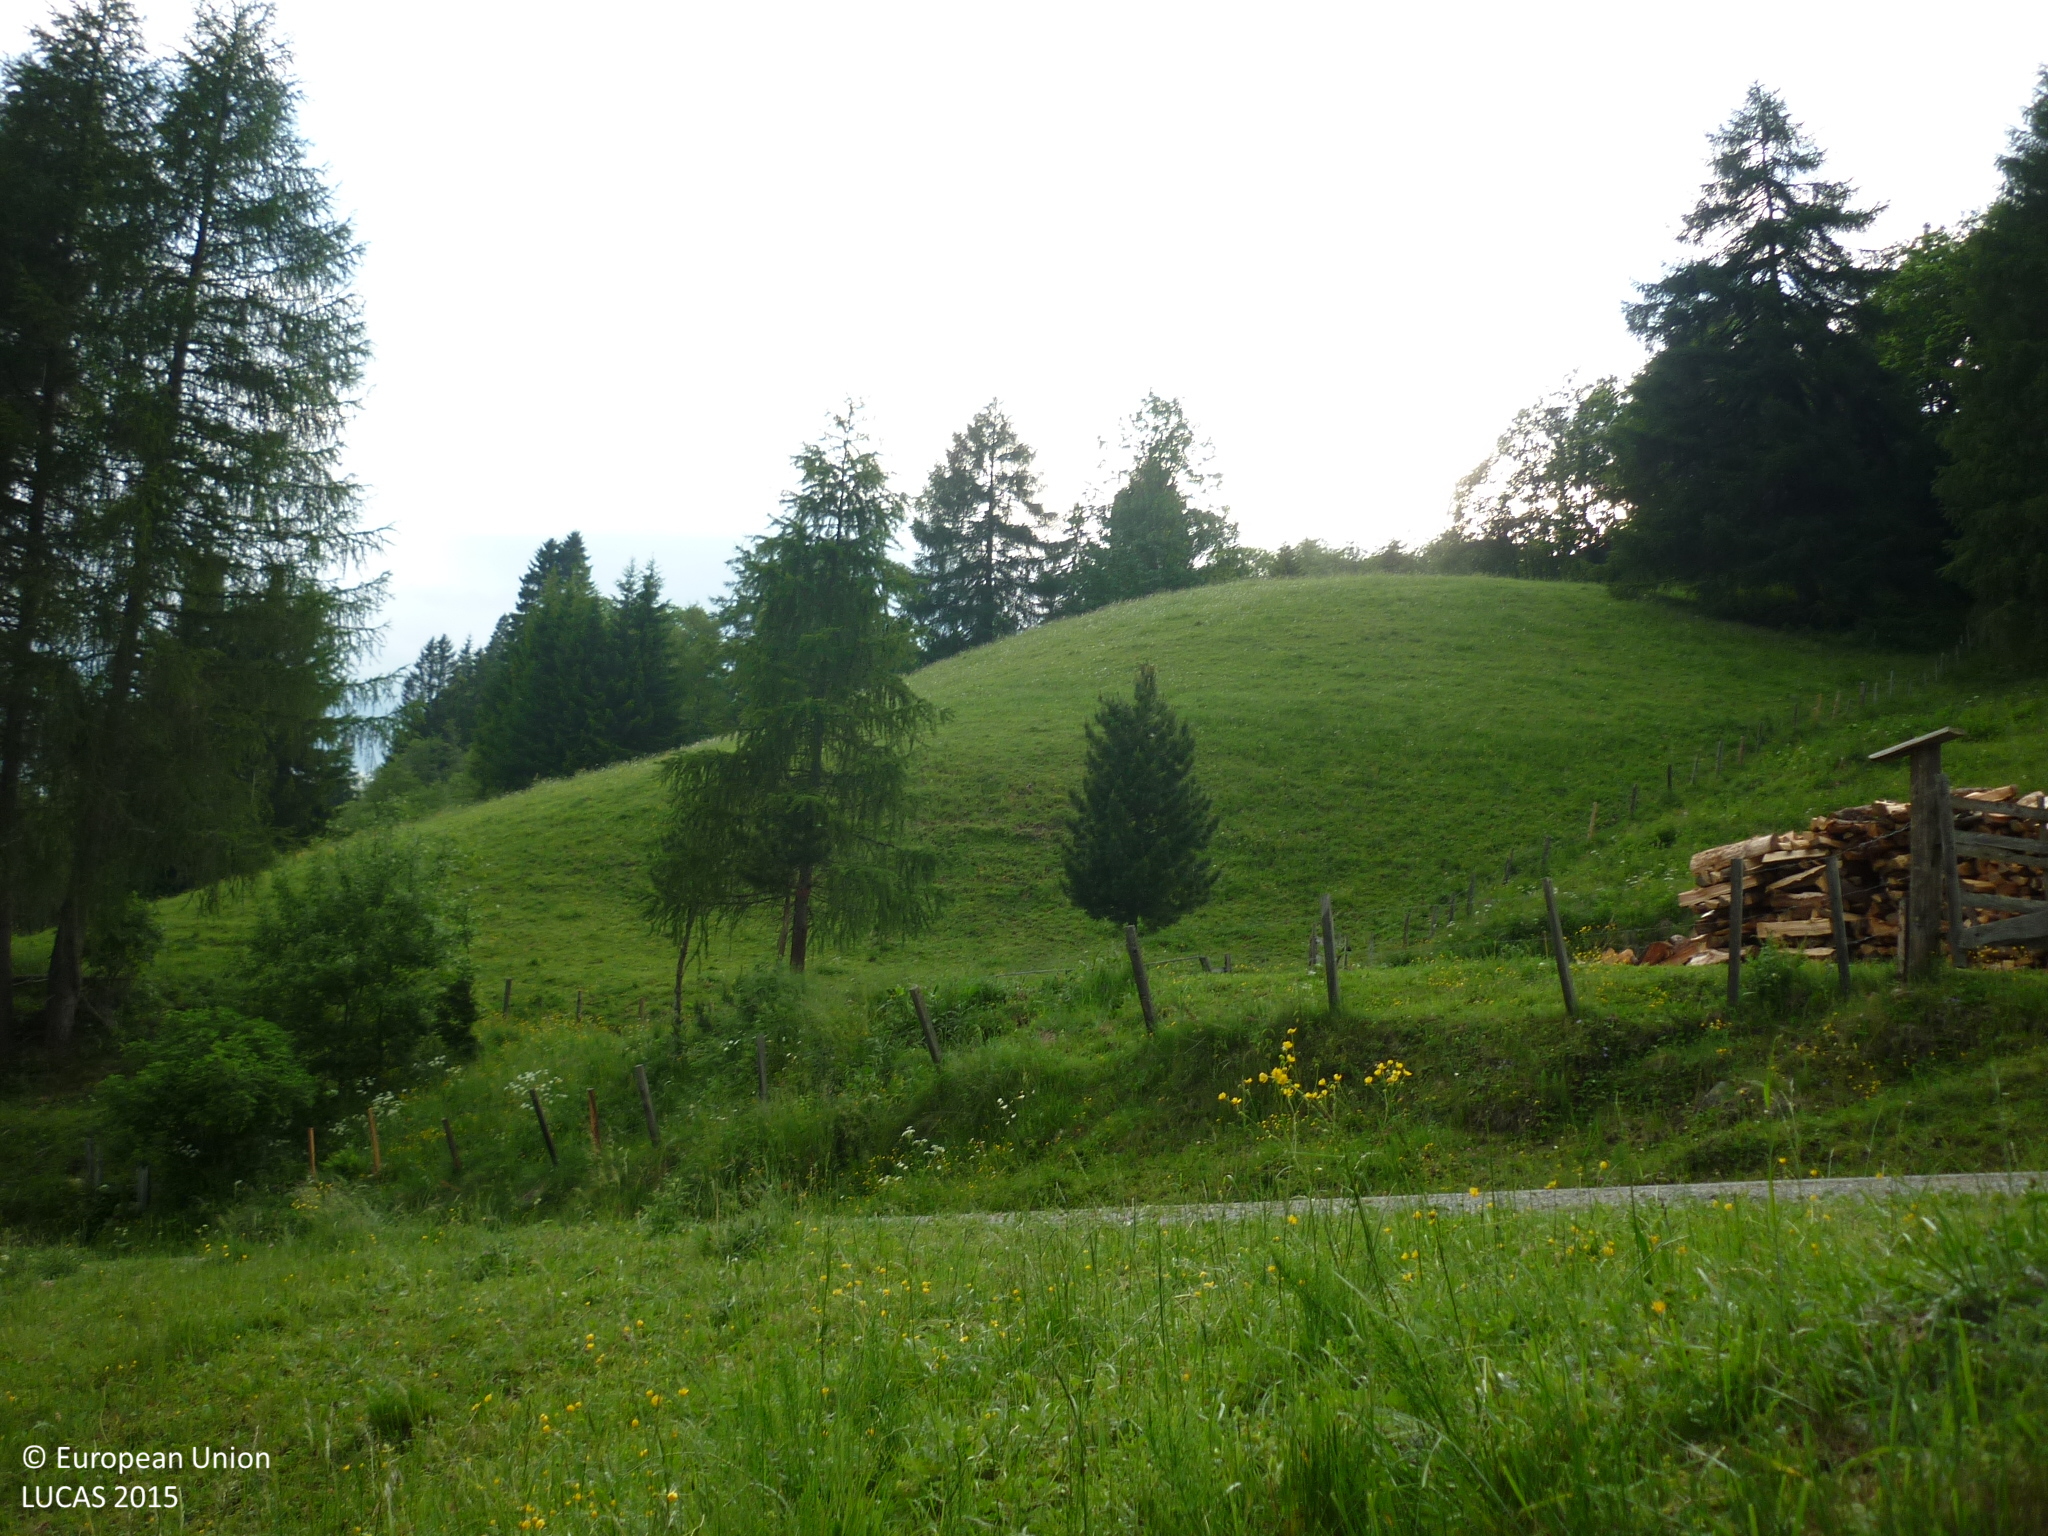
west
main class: Grassland
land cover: Grassland without tree/shrub cover
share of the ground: > 75 %
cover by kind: herbaceous plants 100 %
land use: Agriculture (excluding fallow land and kitchen gardens)
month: June
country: AT
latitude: 47.1610
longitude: 13.9686
